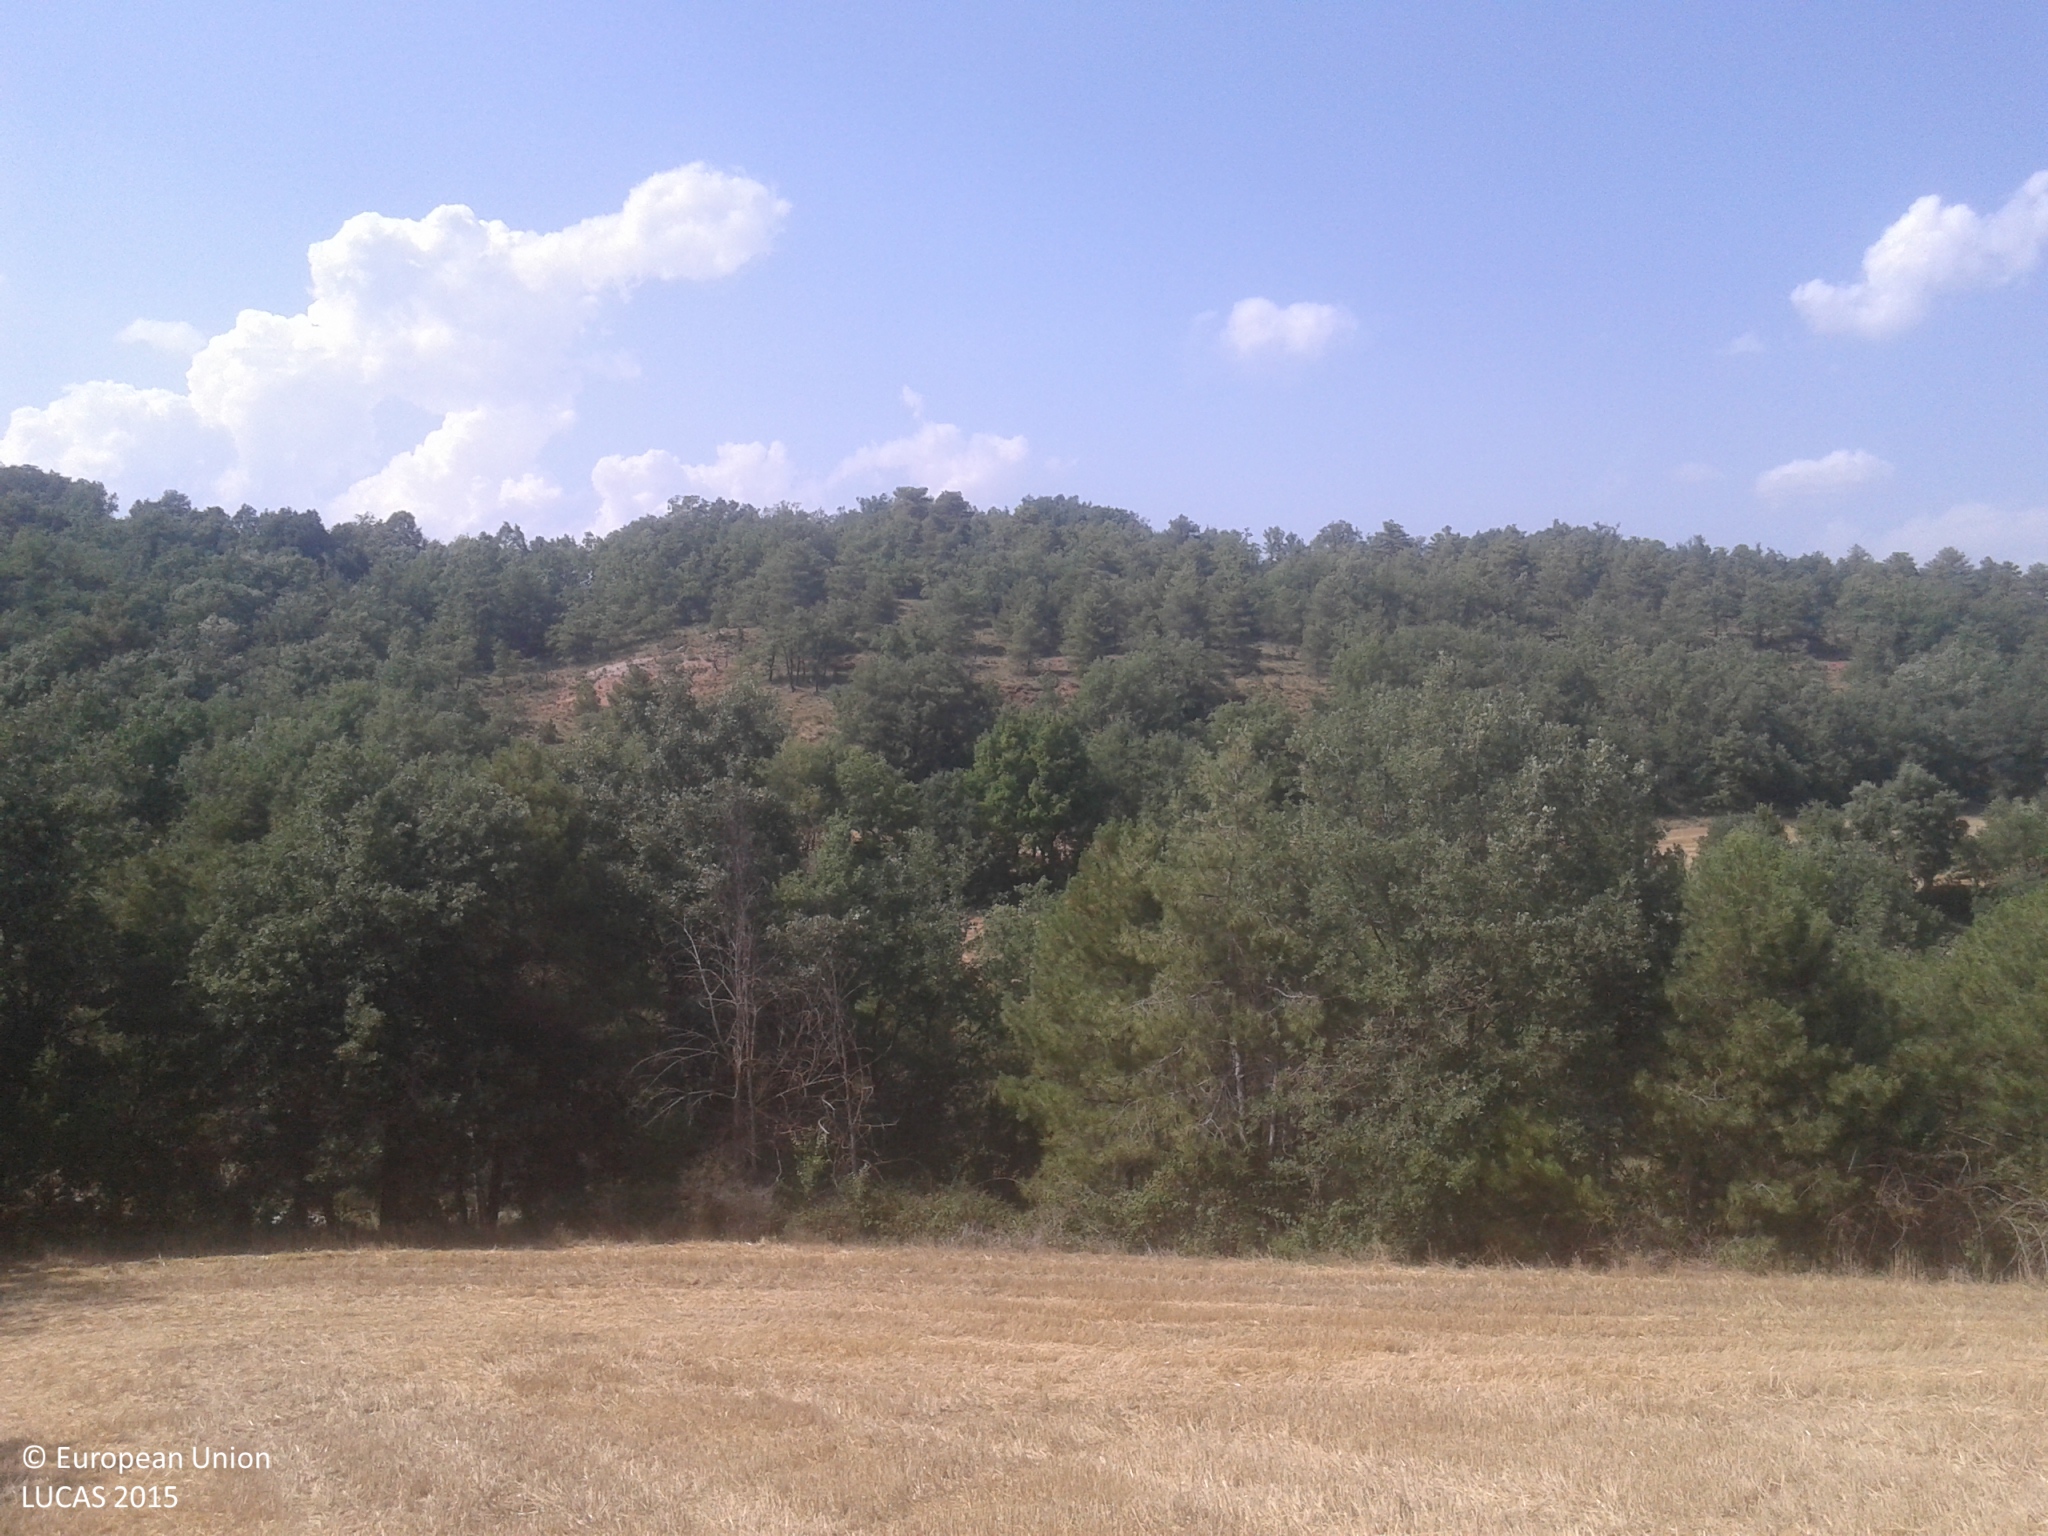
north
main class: Cropland
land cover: Common wheat
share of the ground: < 10 %
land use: Agriculture (excluding fallow land and kitchen gardens)
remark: Harvested field
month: July
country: ES
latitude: 42.0579
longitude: 1.0563
